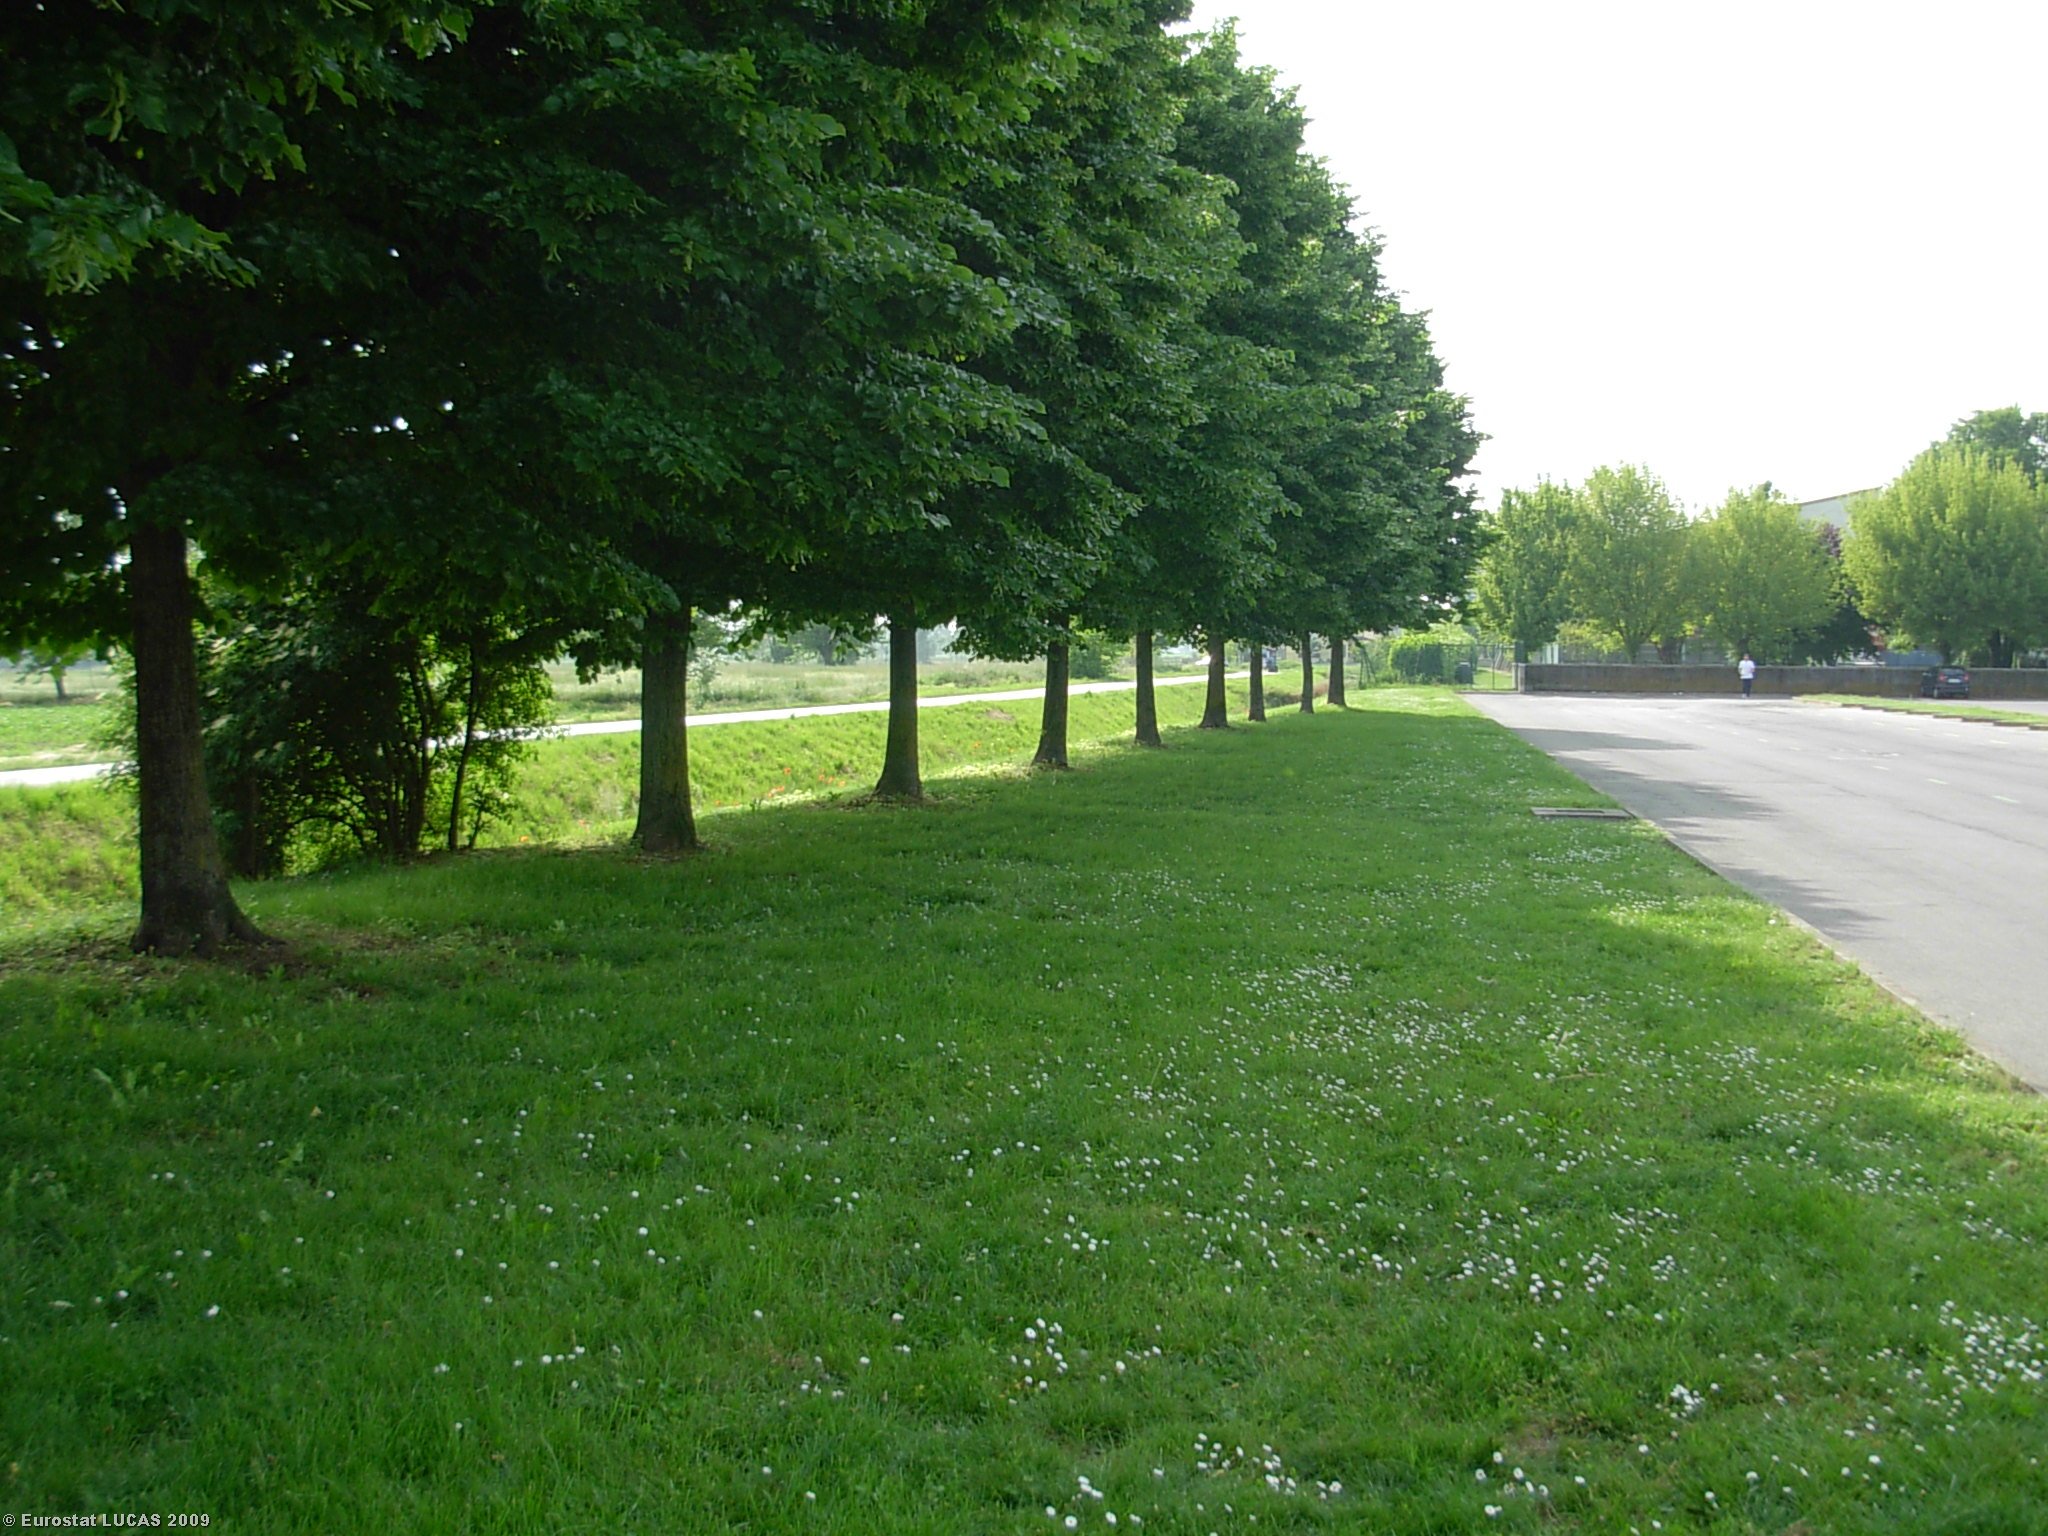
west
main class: Woodland
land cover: Broadleaved woodland
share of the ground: > 75 %
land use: Community services
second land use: Amenities, museums, leisure
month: May
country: IT
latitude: 45.3959
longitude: 10.2678
